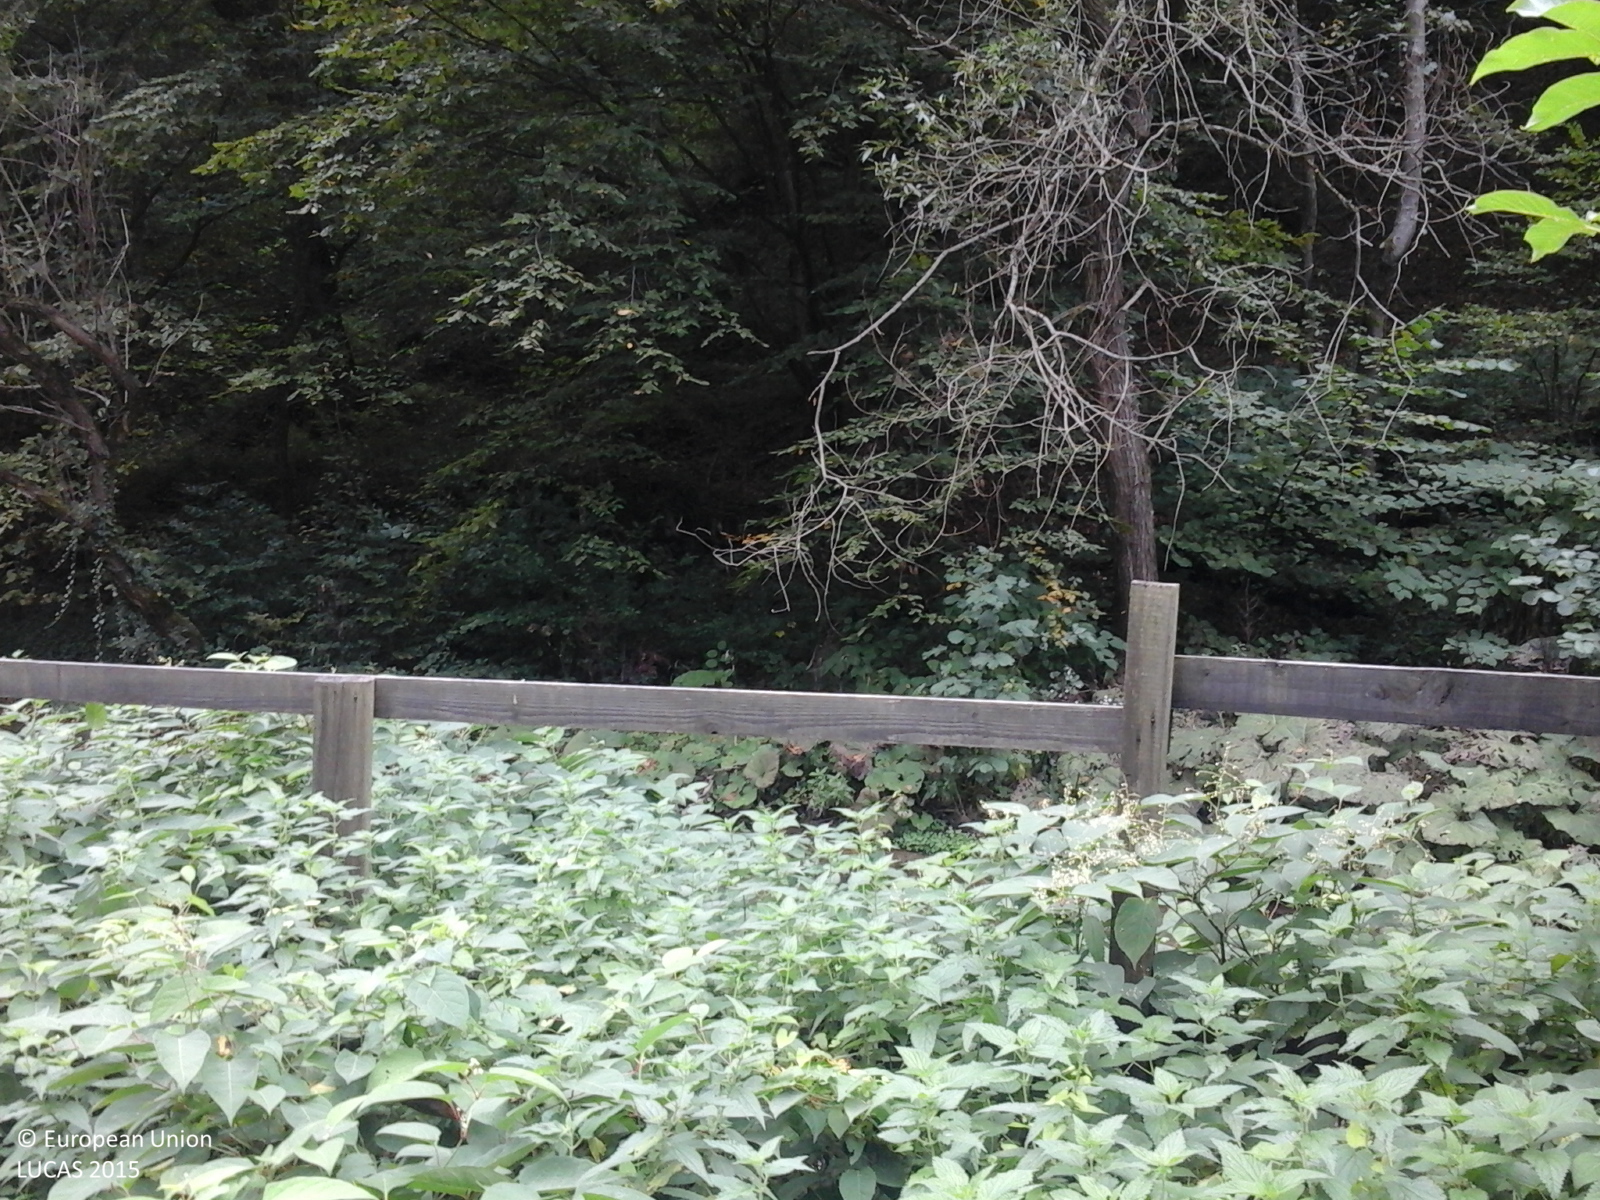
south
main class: Grassland
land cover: Grassland without tree/shrub cover
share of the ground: > 75 %
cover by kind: herbaceous plants 100 %
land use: Residential
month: September
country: RO
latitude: 45.7439
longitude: 22.7888
